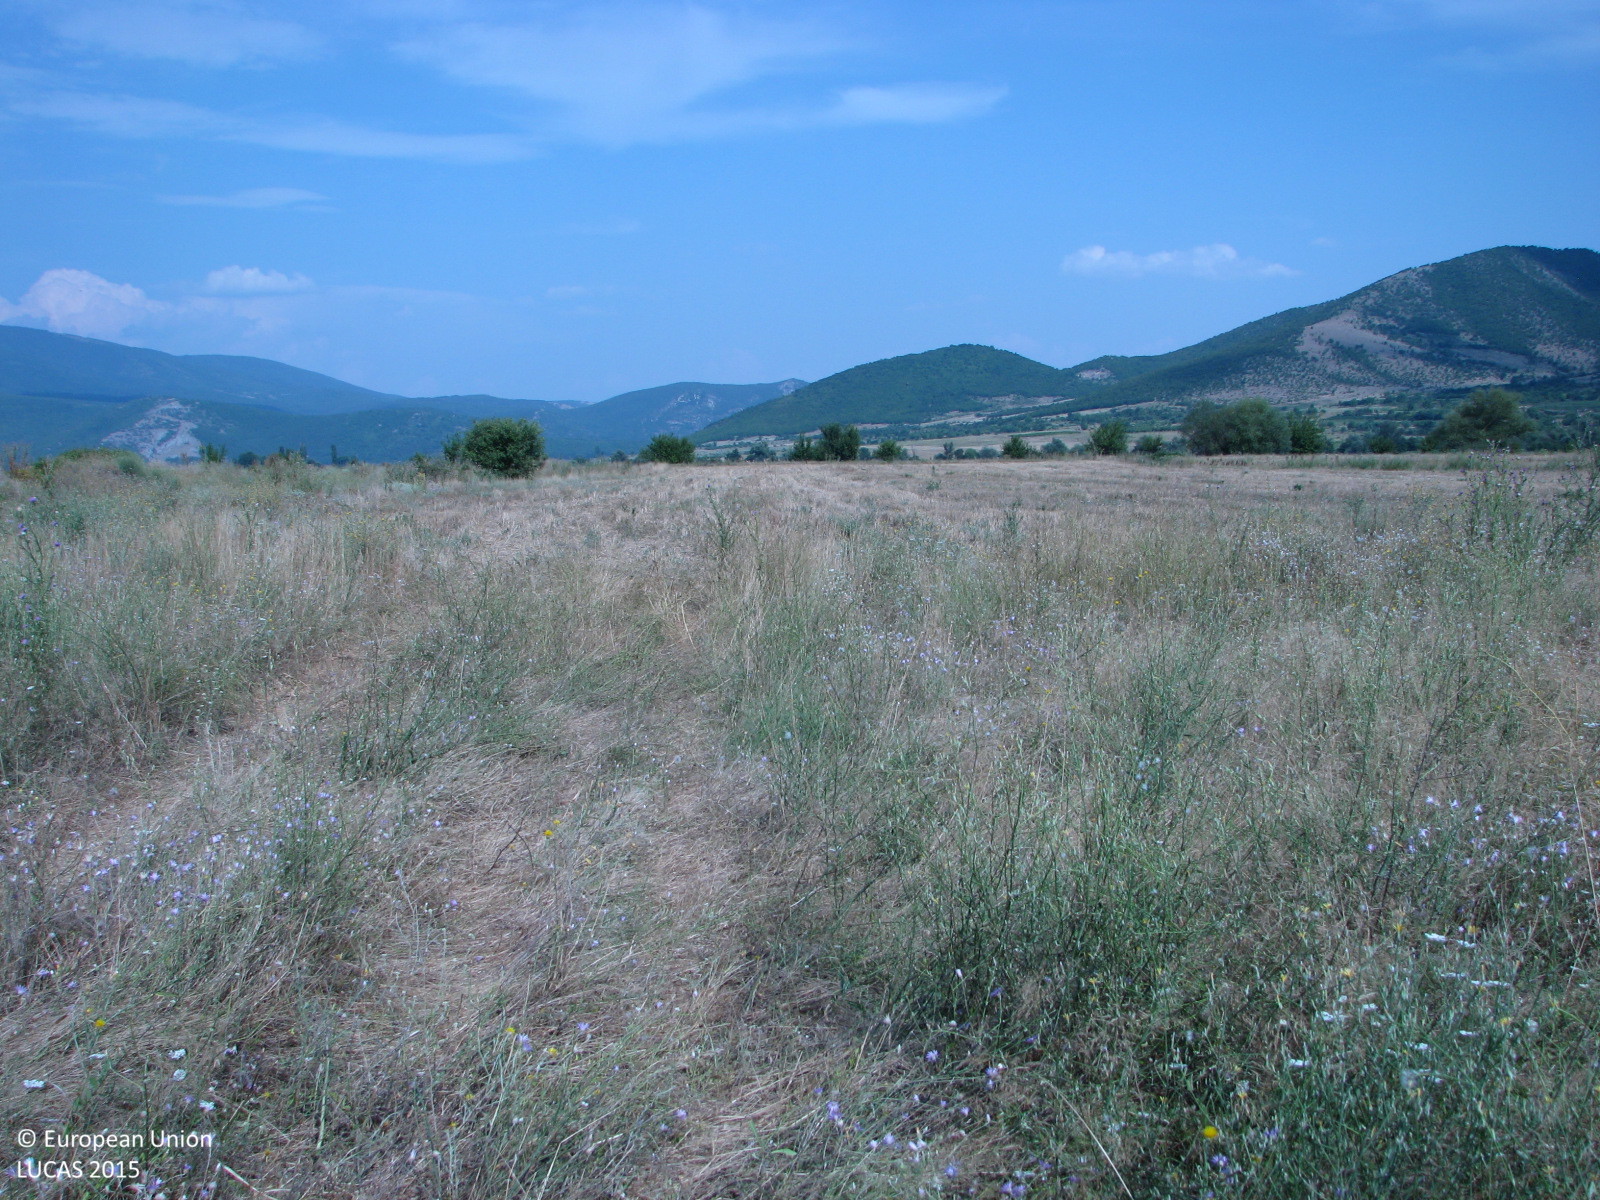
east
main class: Grassland
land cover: Grassland without tree/shrub cover
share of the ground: > 75 %
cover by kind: herbaceous plants 100 %
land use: Agriculture (excluding fallow land and kitchen gardens)
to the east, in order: Grassland without tree/shrub cover; Common wheat; Grass margins; Ditches and canals; Grassland without tree/shrub cover; Tracks; Grass margins; Inland fresh running water; Grass margins; Paved roads, cycling and walking lanes; Grass margins; Ditches and canals; Grass margins; Grassland without tree/shrub cover; Ditches and canals; Common wheat
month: July
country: BG
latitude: 42.6719
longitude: 26.0317
